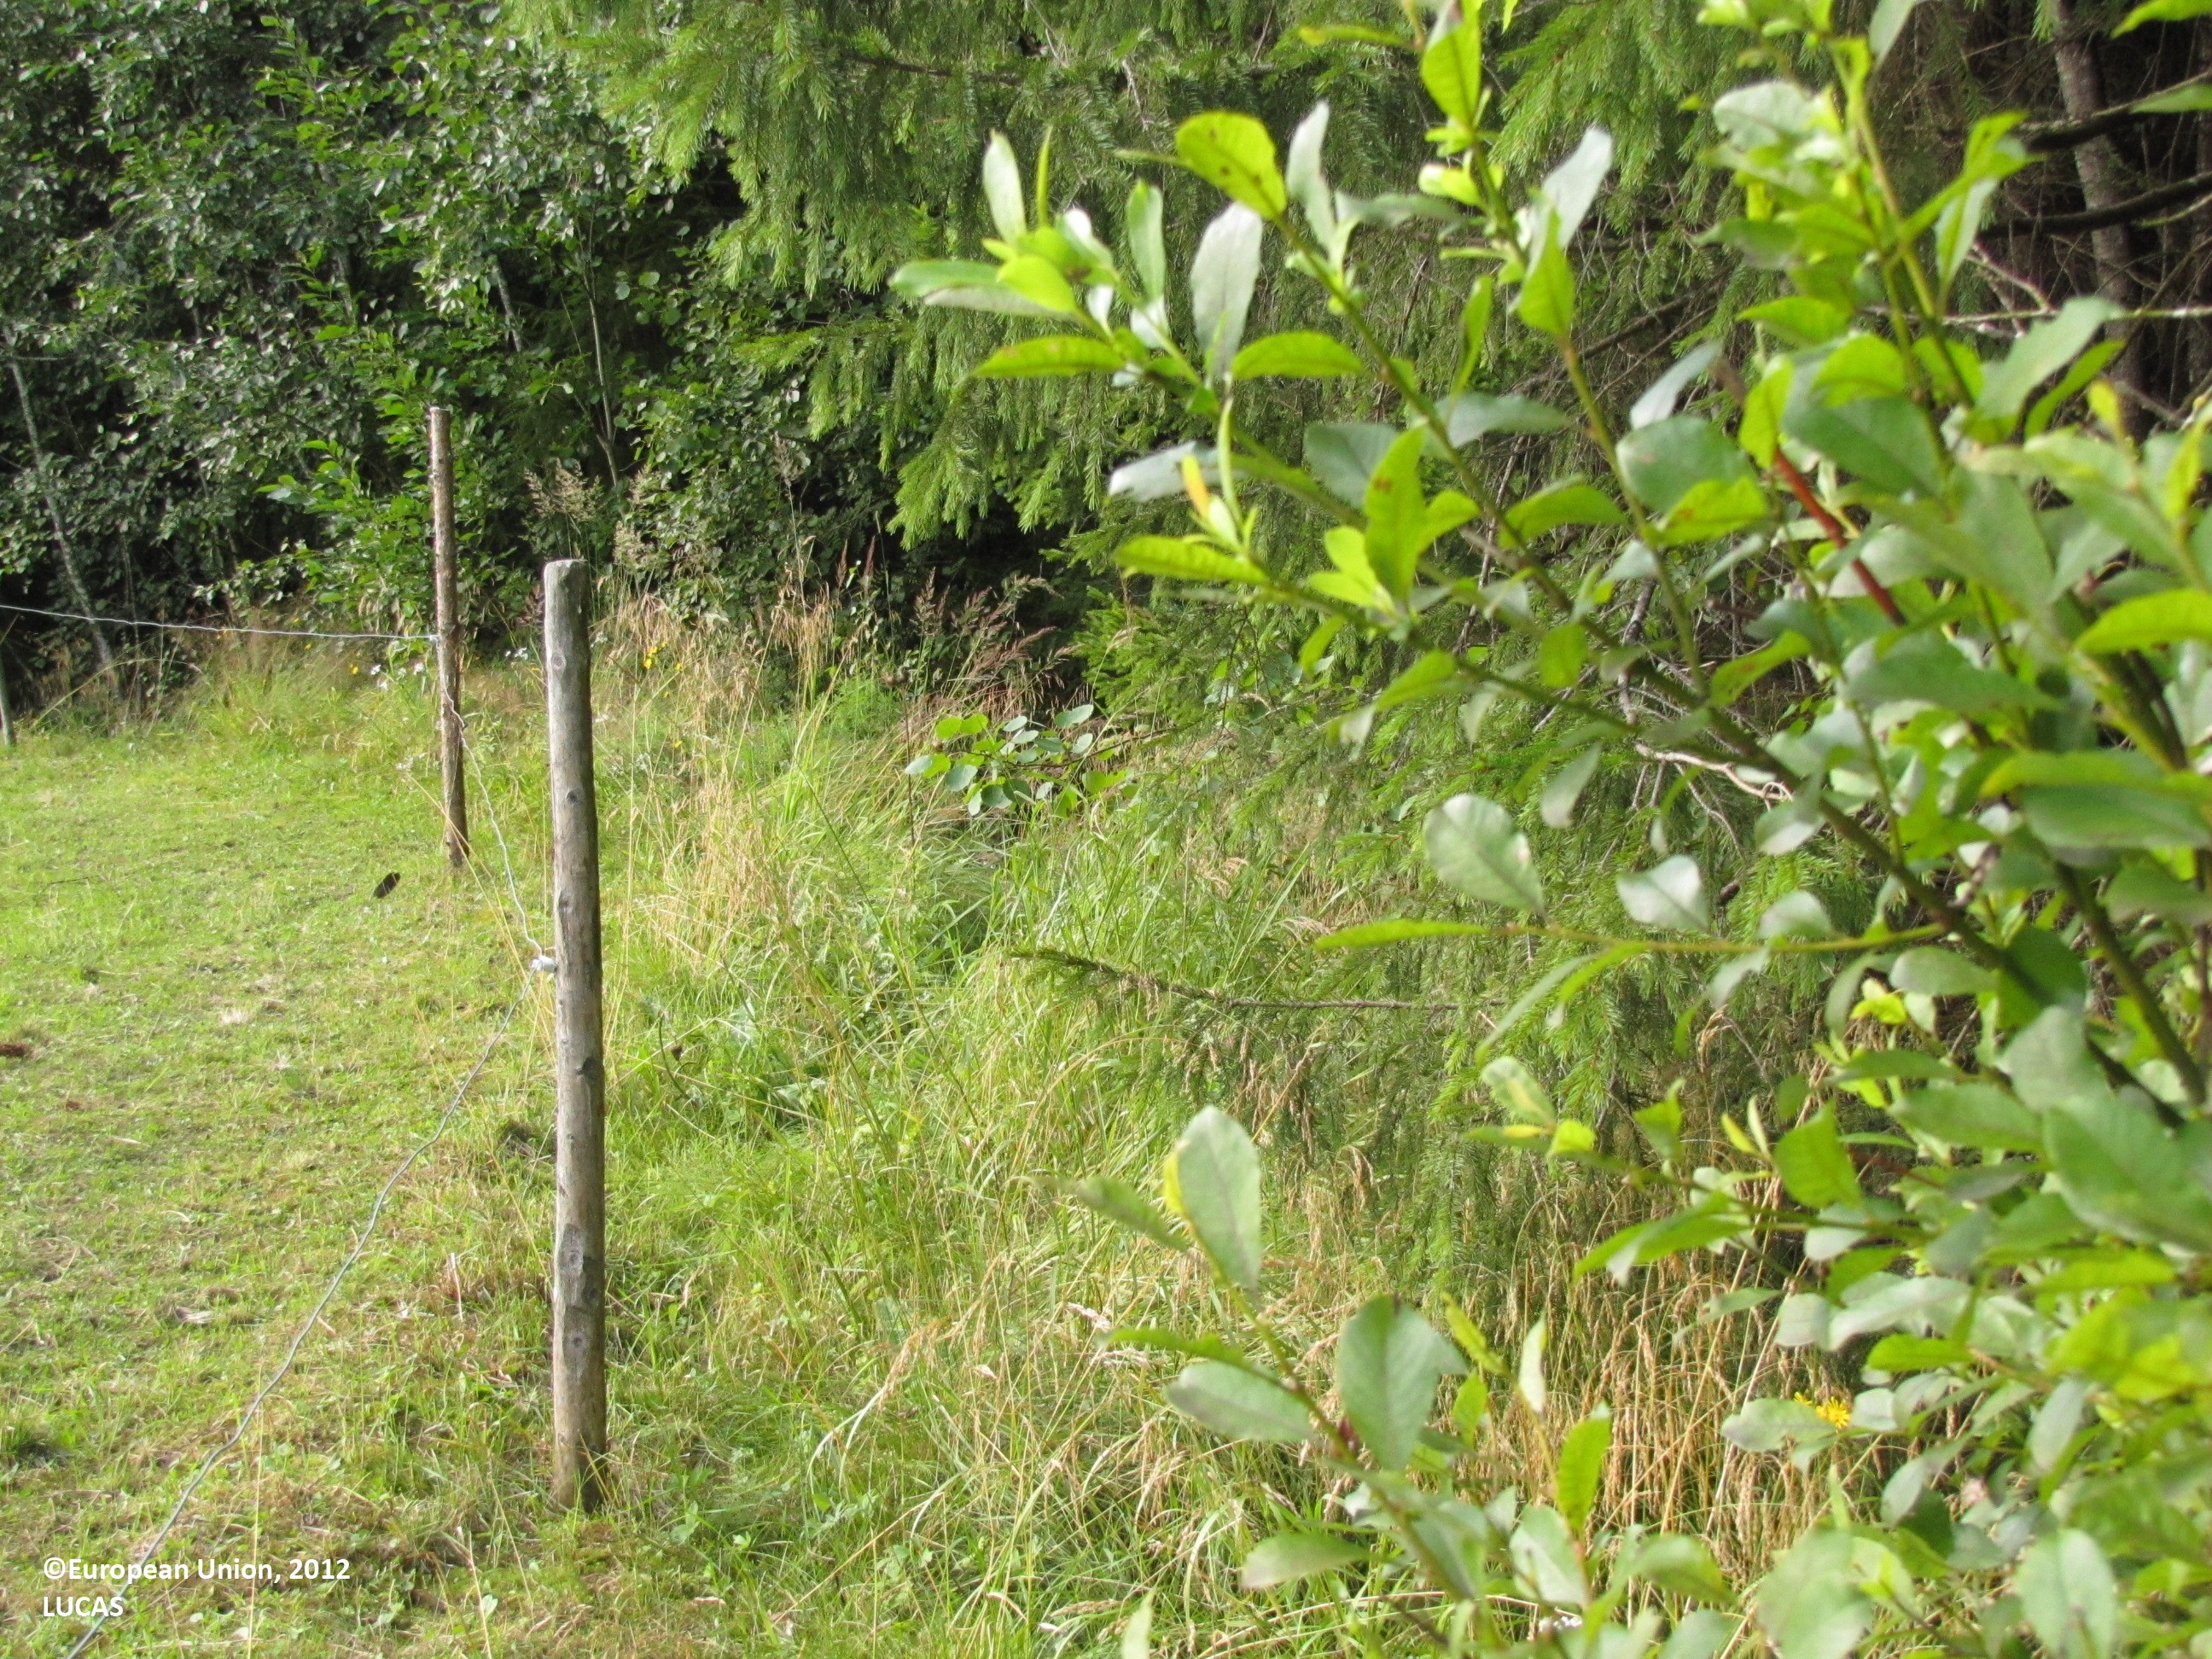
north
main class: Grassland
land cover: Grassland without tree/shrub cover
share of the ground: 50 - 75 %
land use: Agriculture (excluding fallow land and kitchen gardens)
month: August
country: FI
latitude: 61.7412
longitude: 22.9238
